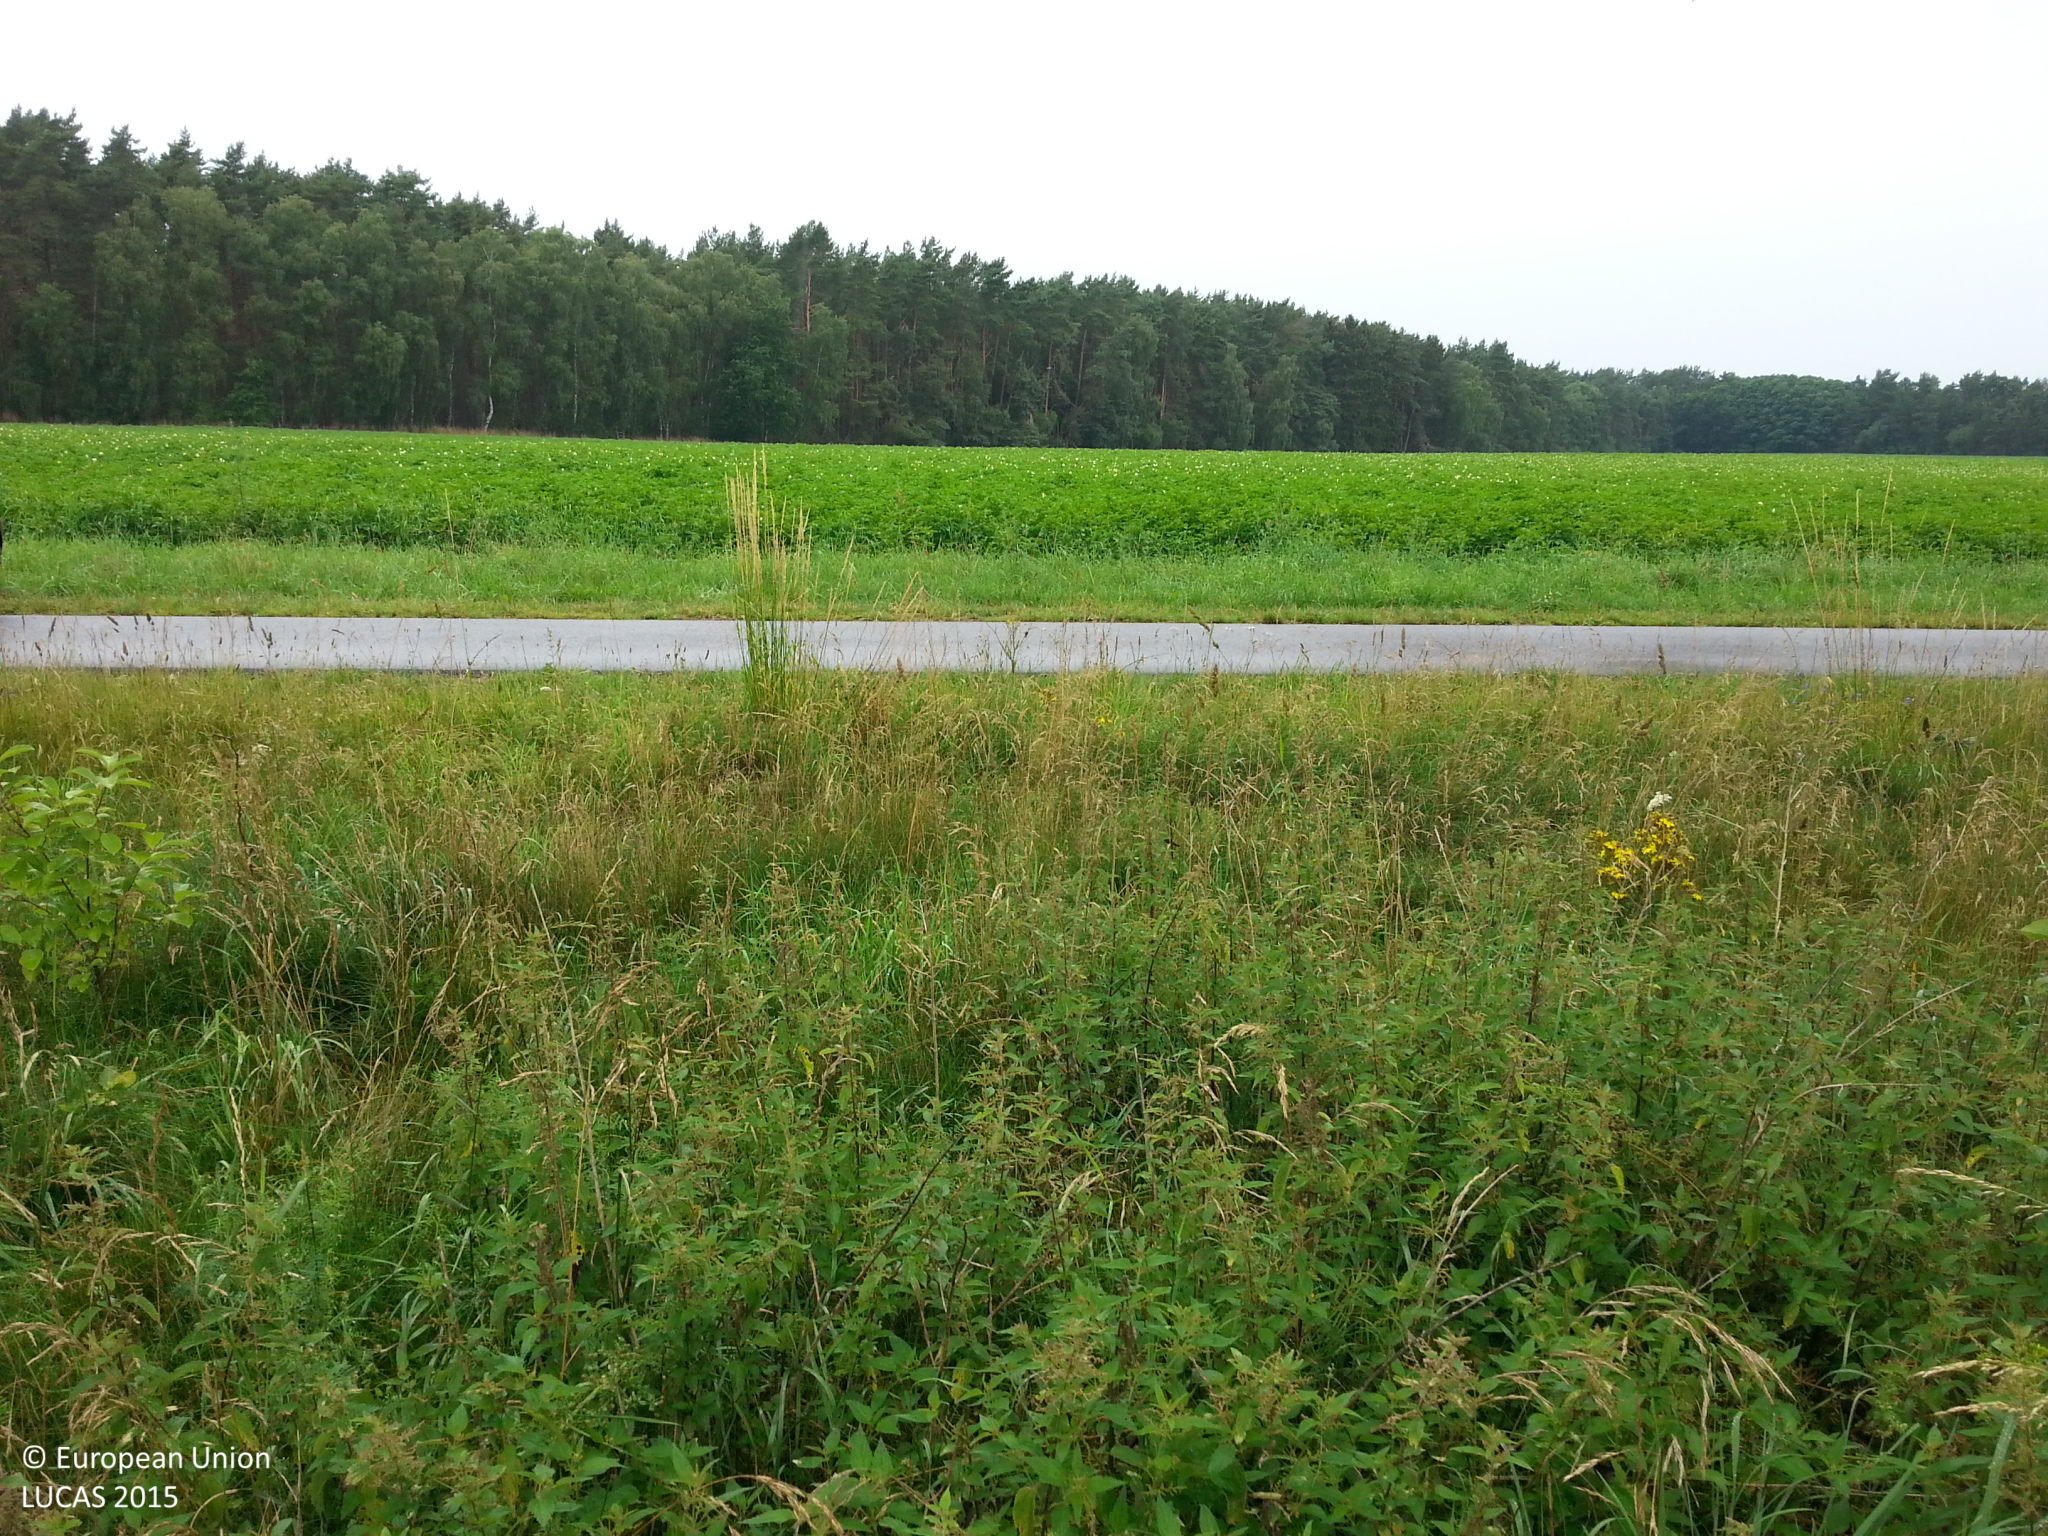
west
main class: Cropland
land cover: Maize
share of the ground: > 75 %
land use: Agriculture (excluding fallow land and kitchen gardens)
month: July
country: DE
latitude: 53.0740
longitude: 11.0295
